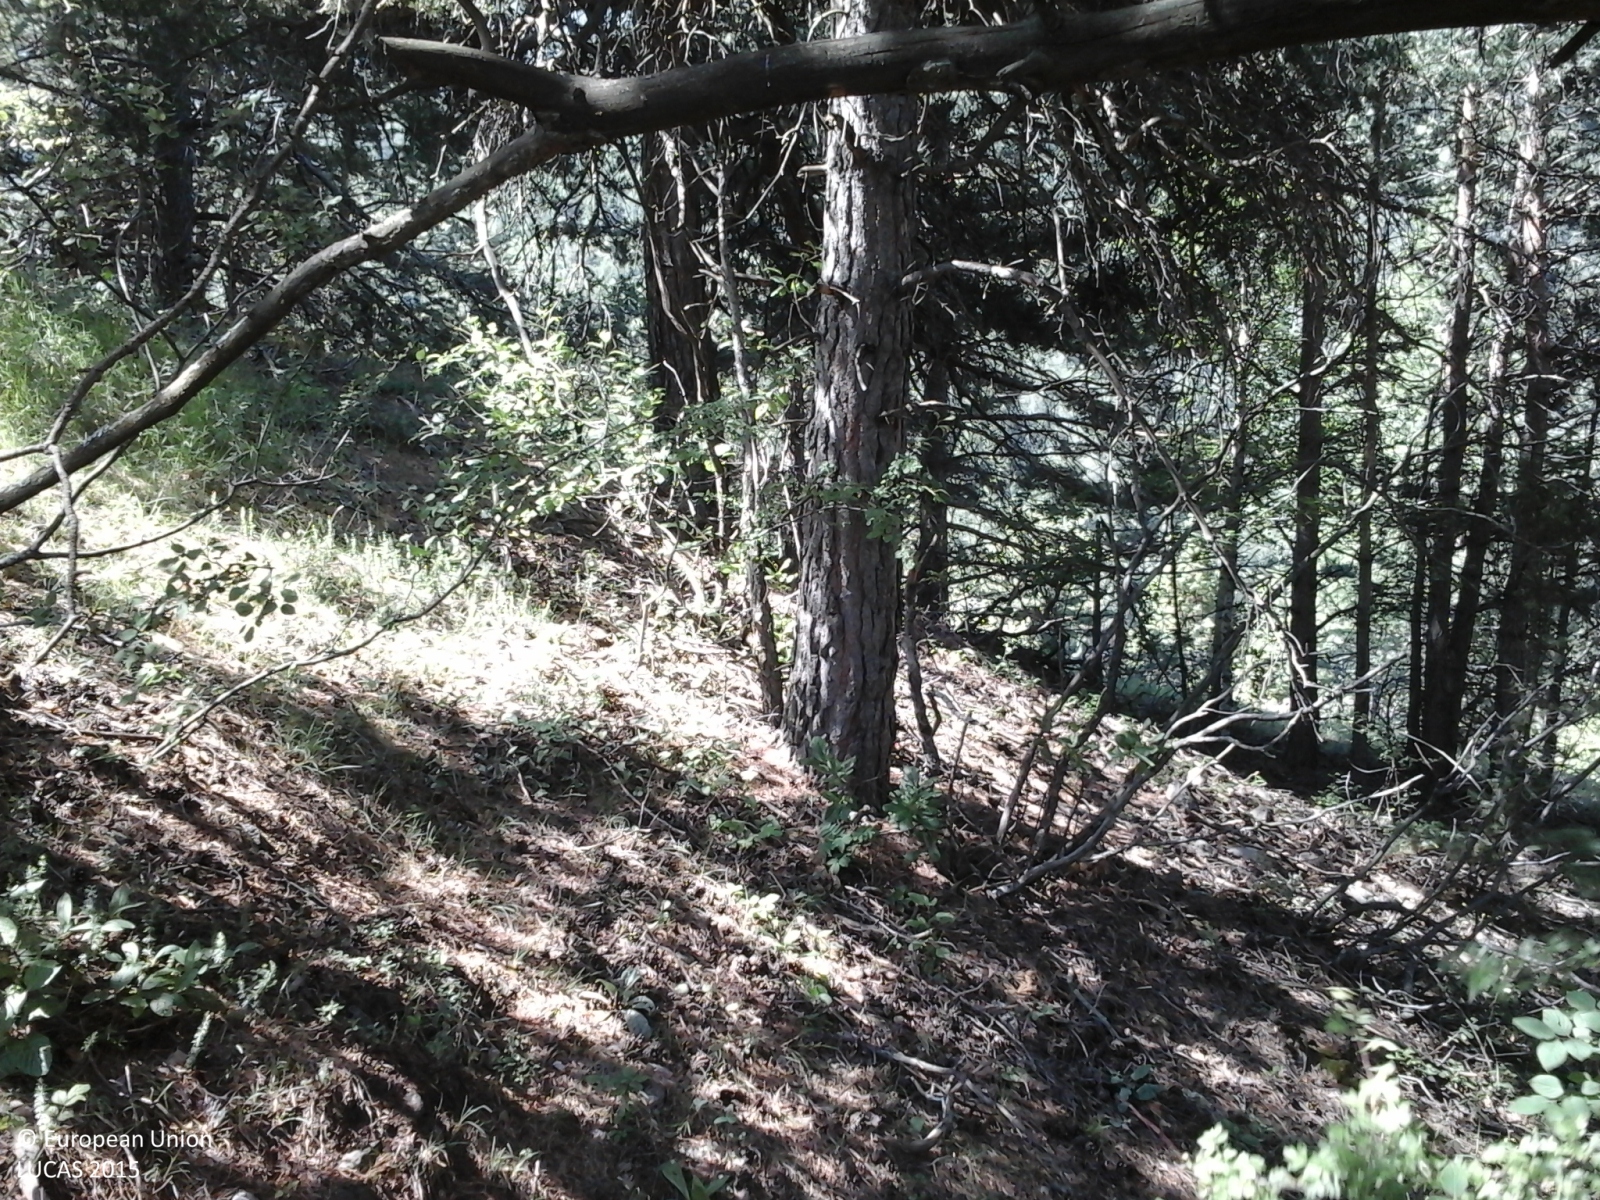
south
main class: Woodland
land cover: Pine dominated coniferous woodland
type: alpine coniferous forest
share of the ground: > 75 %
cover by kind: coniferous forest trees 100 %
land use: Semi-natural and natural areas not in use
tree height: > 5 m
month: June
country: IT
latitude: 45.0401
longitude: 6.7680
